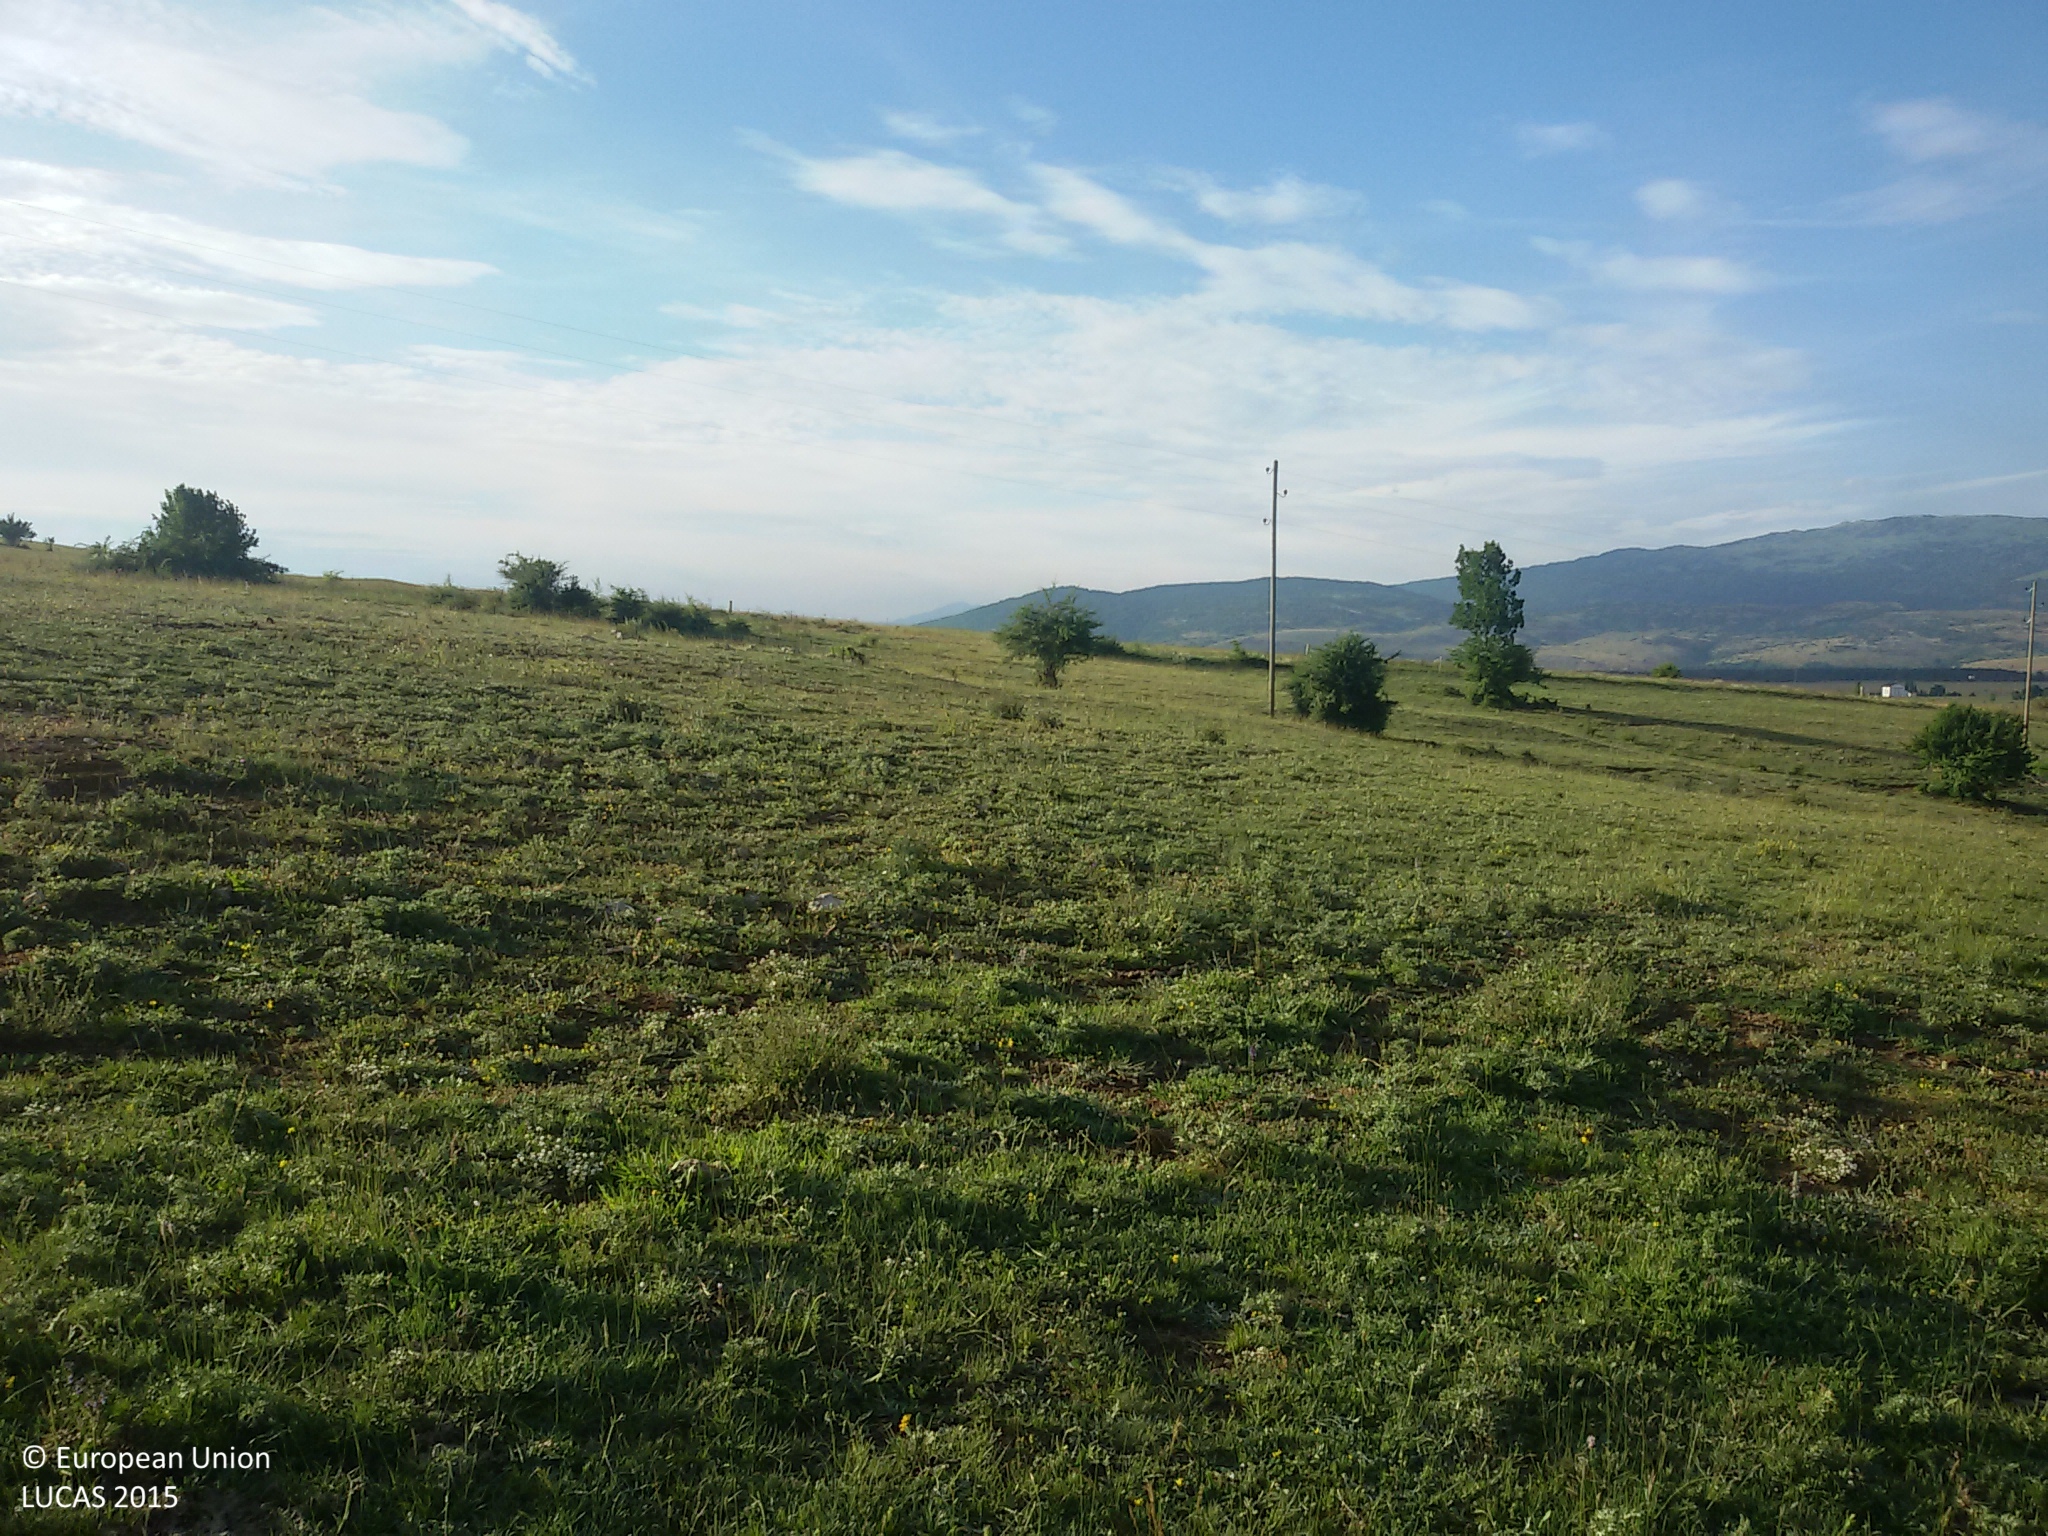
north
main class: Grassland
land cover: Grassland without tree/shrub cover
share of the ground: > 75 %
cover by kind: herbaceous plants 95 %, unconsolidated bare surface 5 %
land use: Agriculture (excluding fallow land and kitchen gardens)
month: June
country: HR
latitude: 44.5349
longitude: 15.7448
